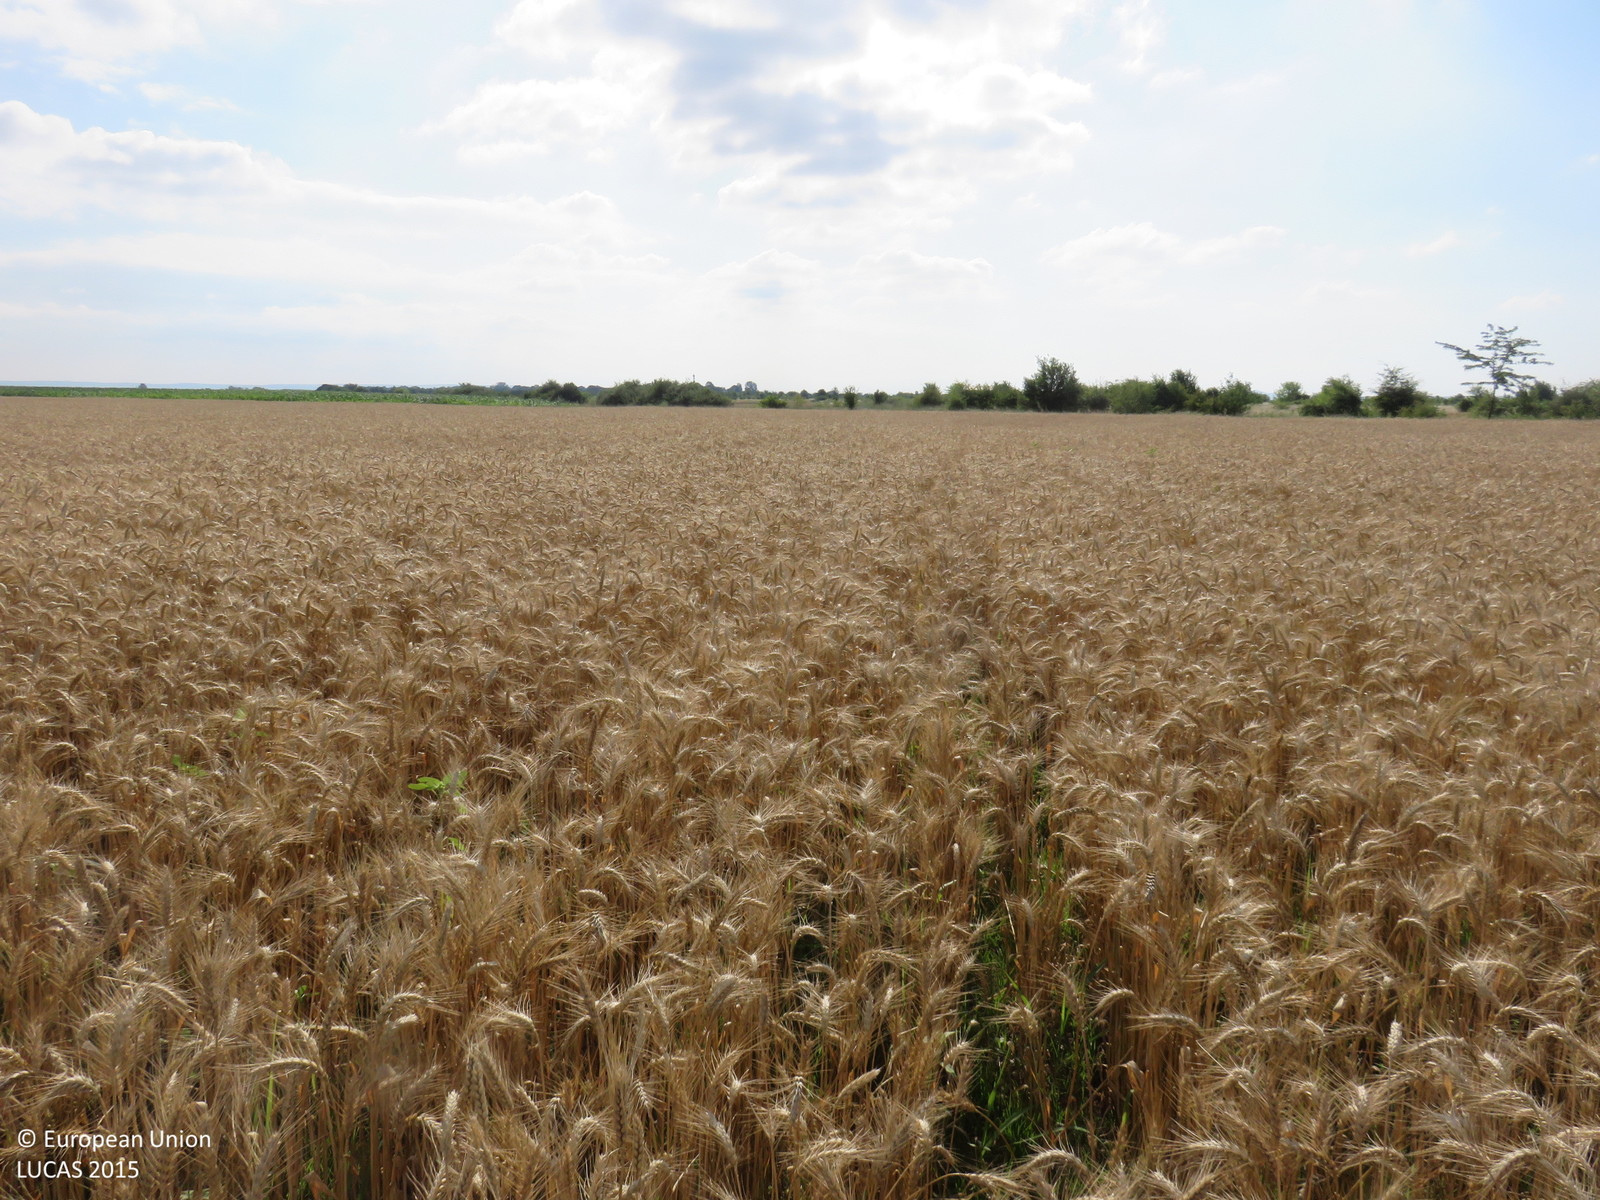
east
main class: Cropland
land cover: Common wheat
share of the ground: > 75 %
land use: Agriculture (excluding fallow land and kitchen gardens)
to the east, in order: Common wheat; Grass margins; Tracks; Grassland without tree/shrub cover; Tracks; Grassland with sparse tree/shrub cover
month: June
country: BG
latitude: 43.3292
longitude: 24.9793
